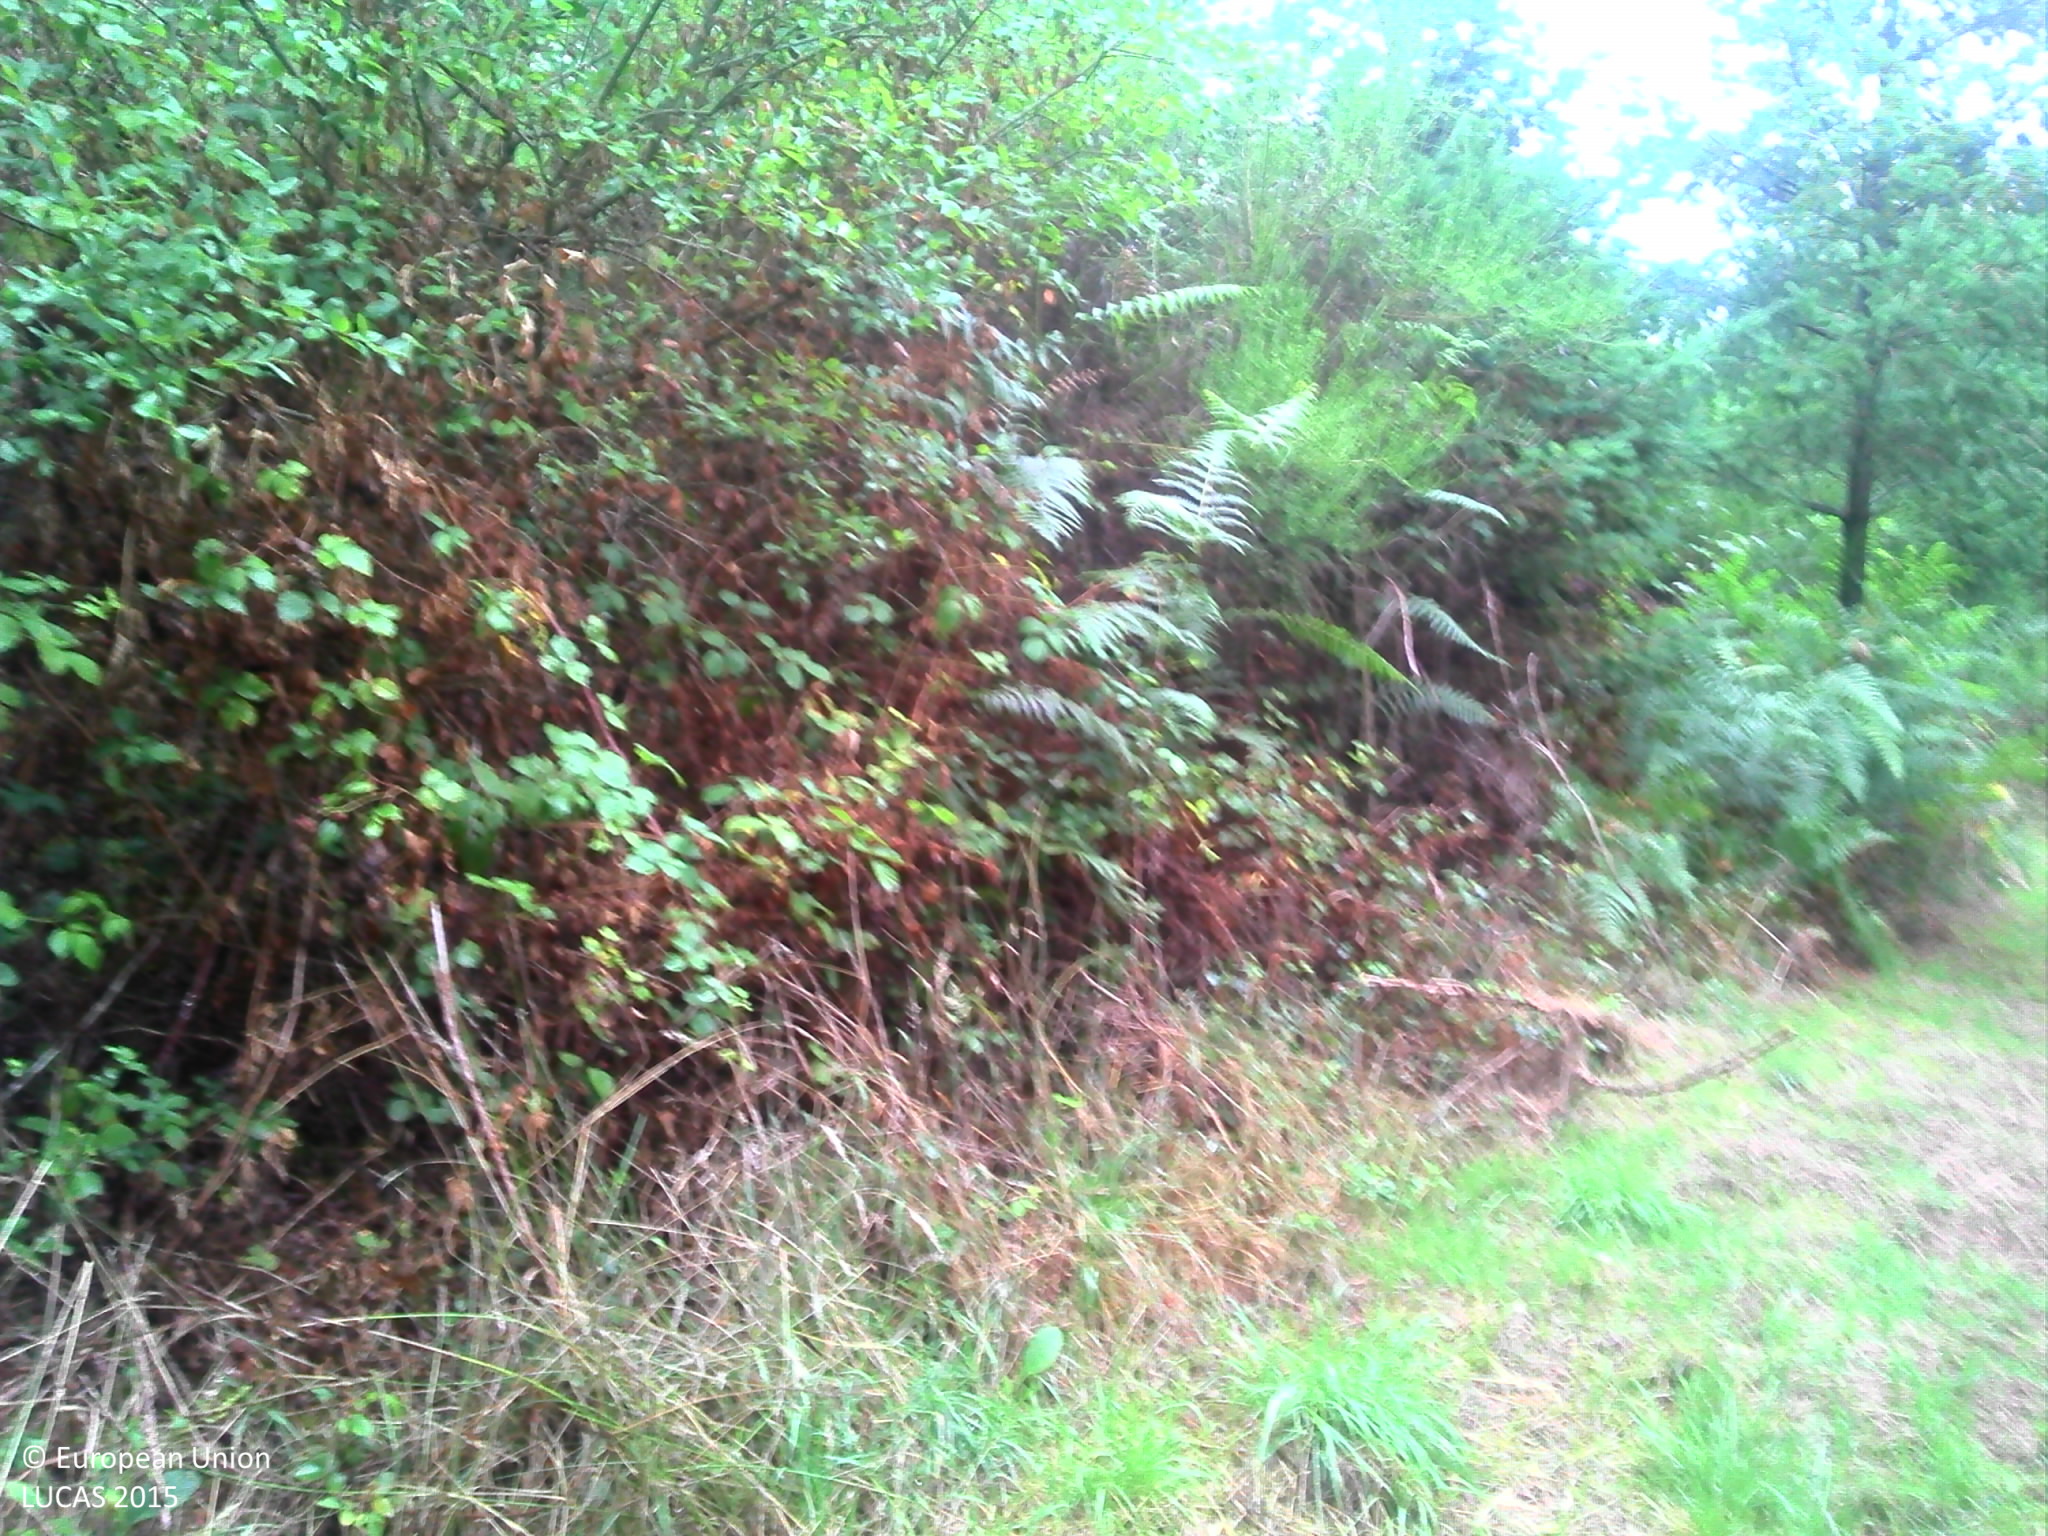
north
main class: Woodland
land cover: Spruce dominated coniferous woodland
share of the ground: > 75 %
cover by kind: coniferous forest trees 95 %, broadleaved forest trees 5 %
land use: Forestry
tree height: > 5 m
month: August
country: FR
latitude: 46.0063
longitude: 0.9873
